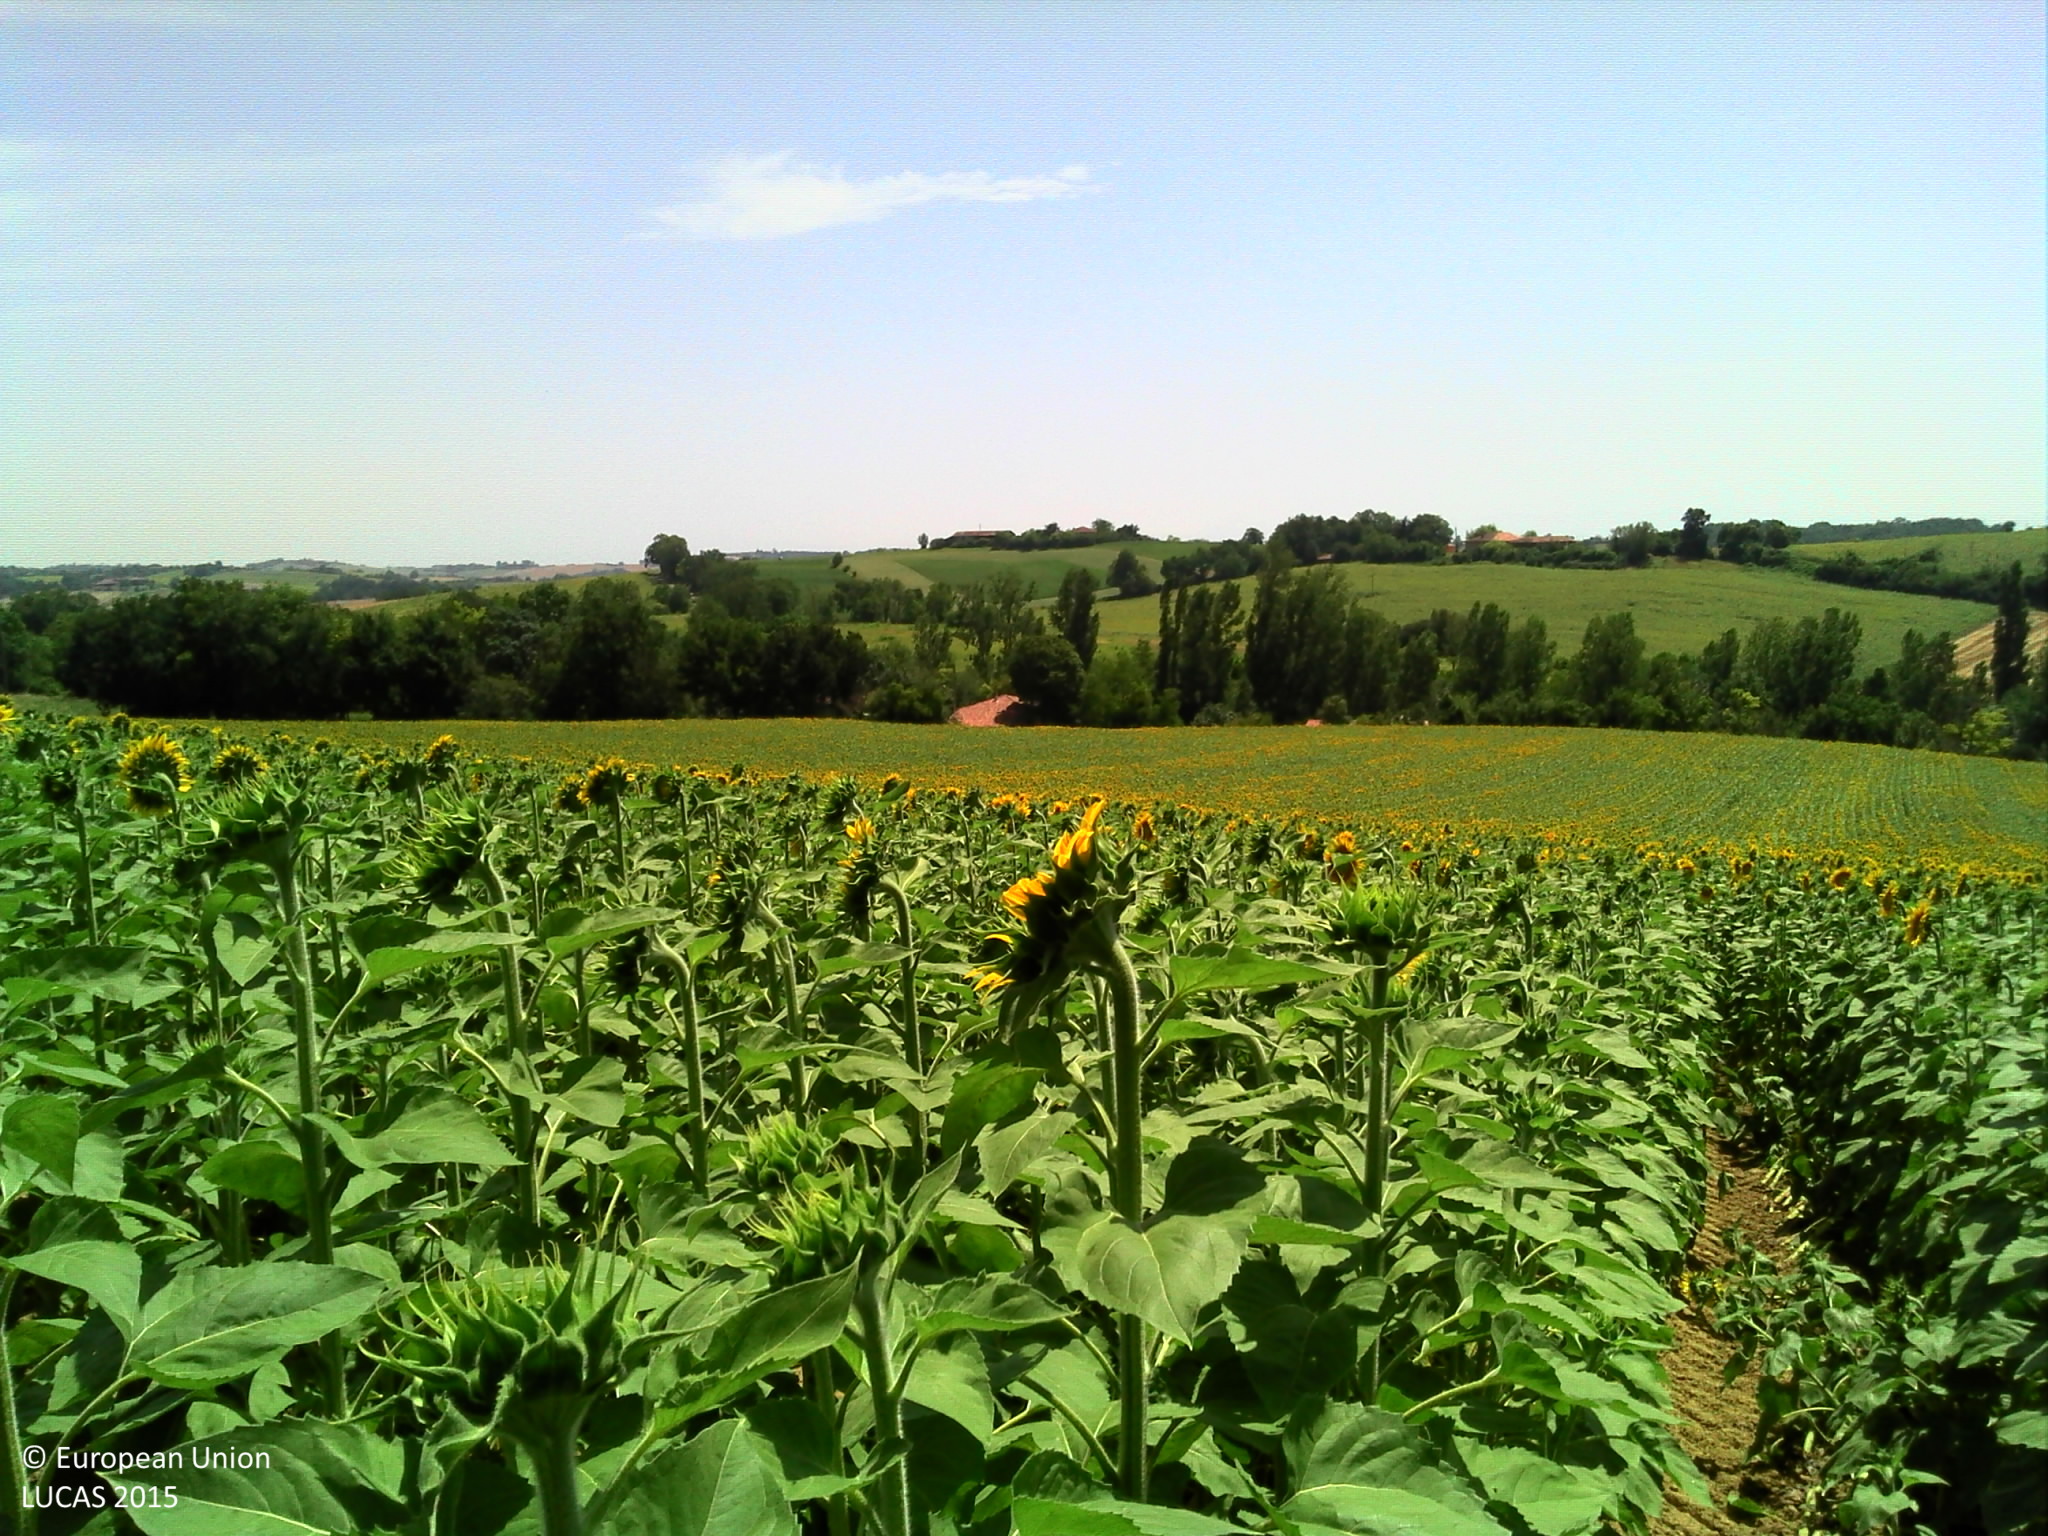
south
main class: Cropland
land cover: Sunflower
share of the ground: > 75 %
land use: Agriculture (excluding fallow land and kitchen gardens)
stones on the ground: < 10 %
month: July
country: FR
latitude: 43.4881
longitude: 1.0117
